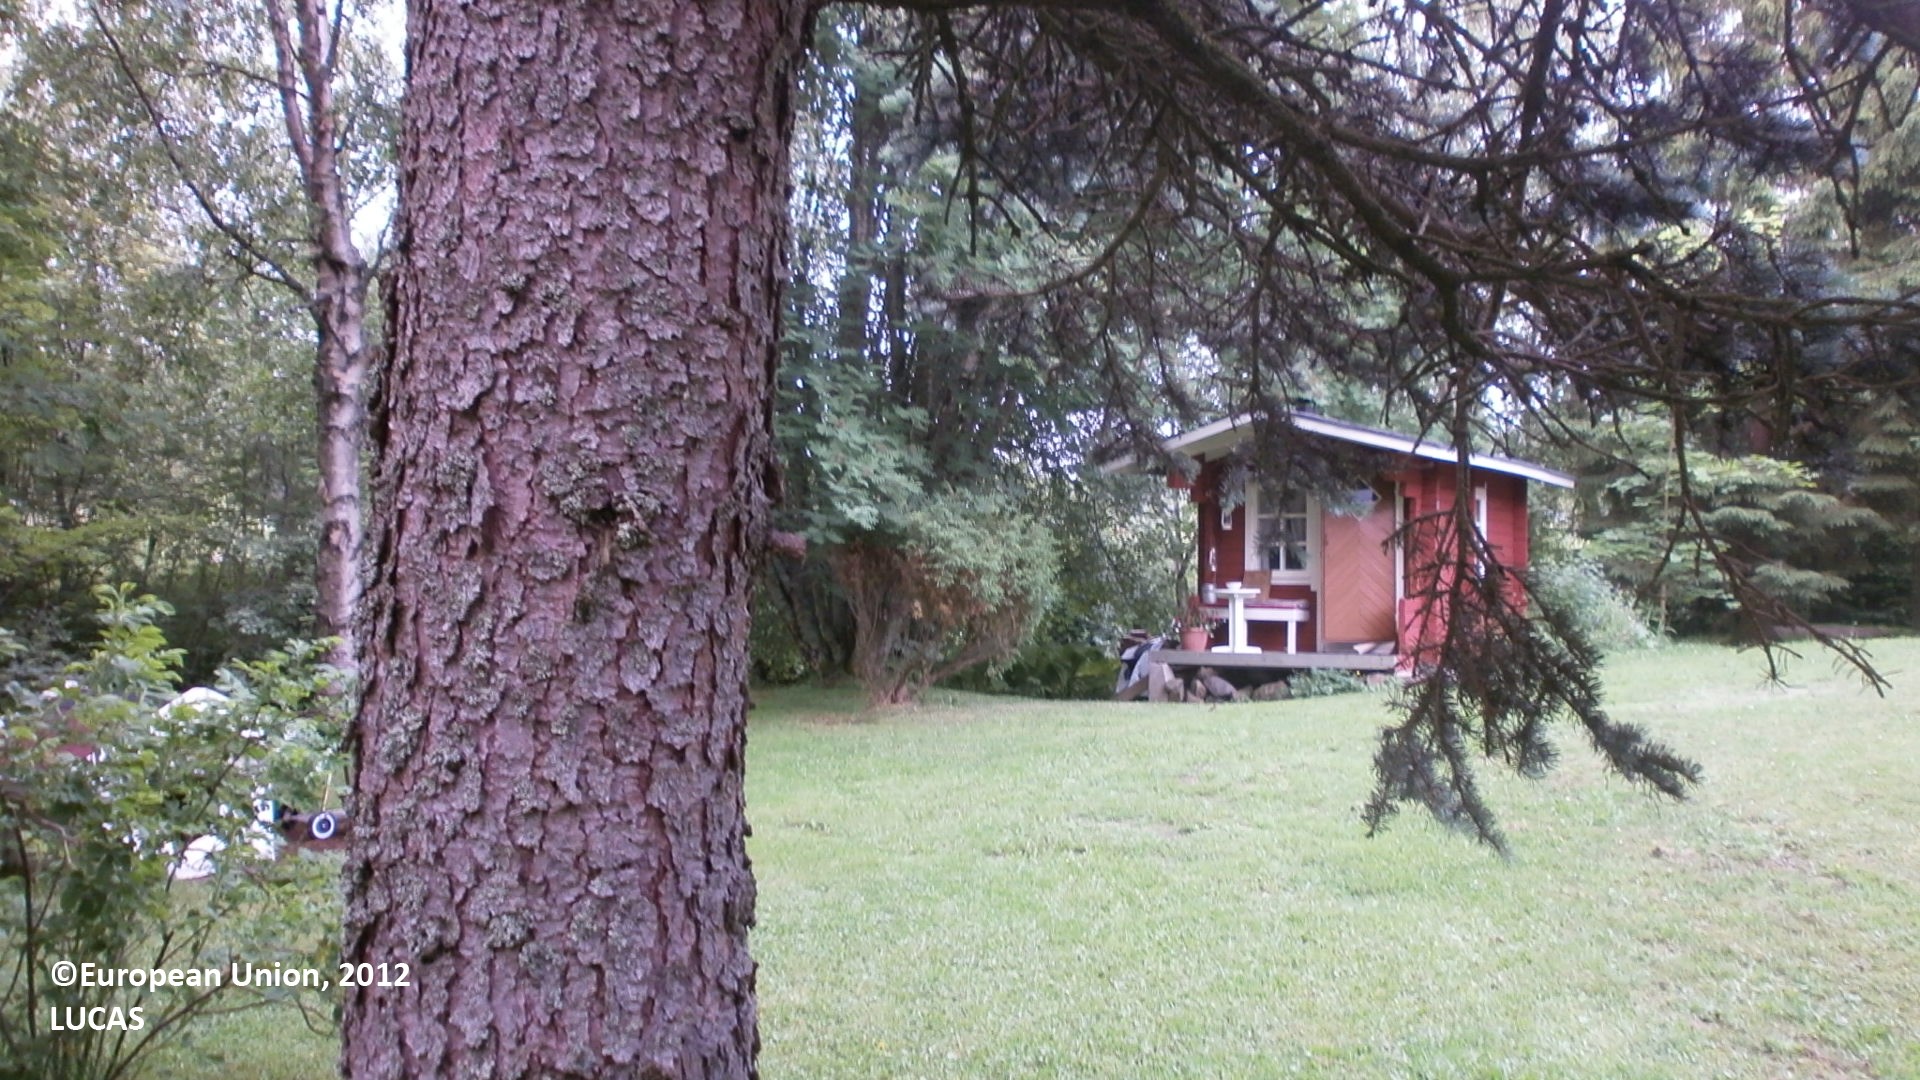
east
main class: Grassland
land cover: Grassland with sparse tree/shrub cover
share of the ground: > 75 %
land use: Residential
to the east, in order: Grassland with sparse tree/shrub cover; Lines of trees; Inland running water; Broadleaved woodland; Ditches and canals; Spontaneously vegetated surfaces; Barley; Shruby margins; Ditches and canals; Shruby margins; Paved roads, cycling and walking lanes; Shruby margins; Ditches and canals; Spontaneously vegetated surfaces; Pine dominated coniferous woodland; Artificial constructions in urban areas
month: July
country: FI
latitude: 64.6777
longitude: 24.5904
